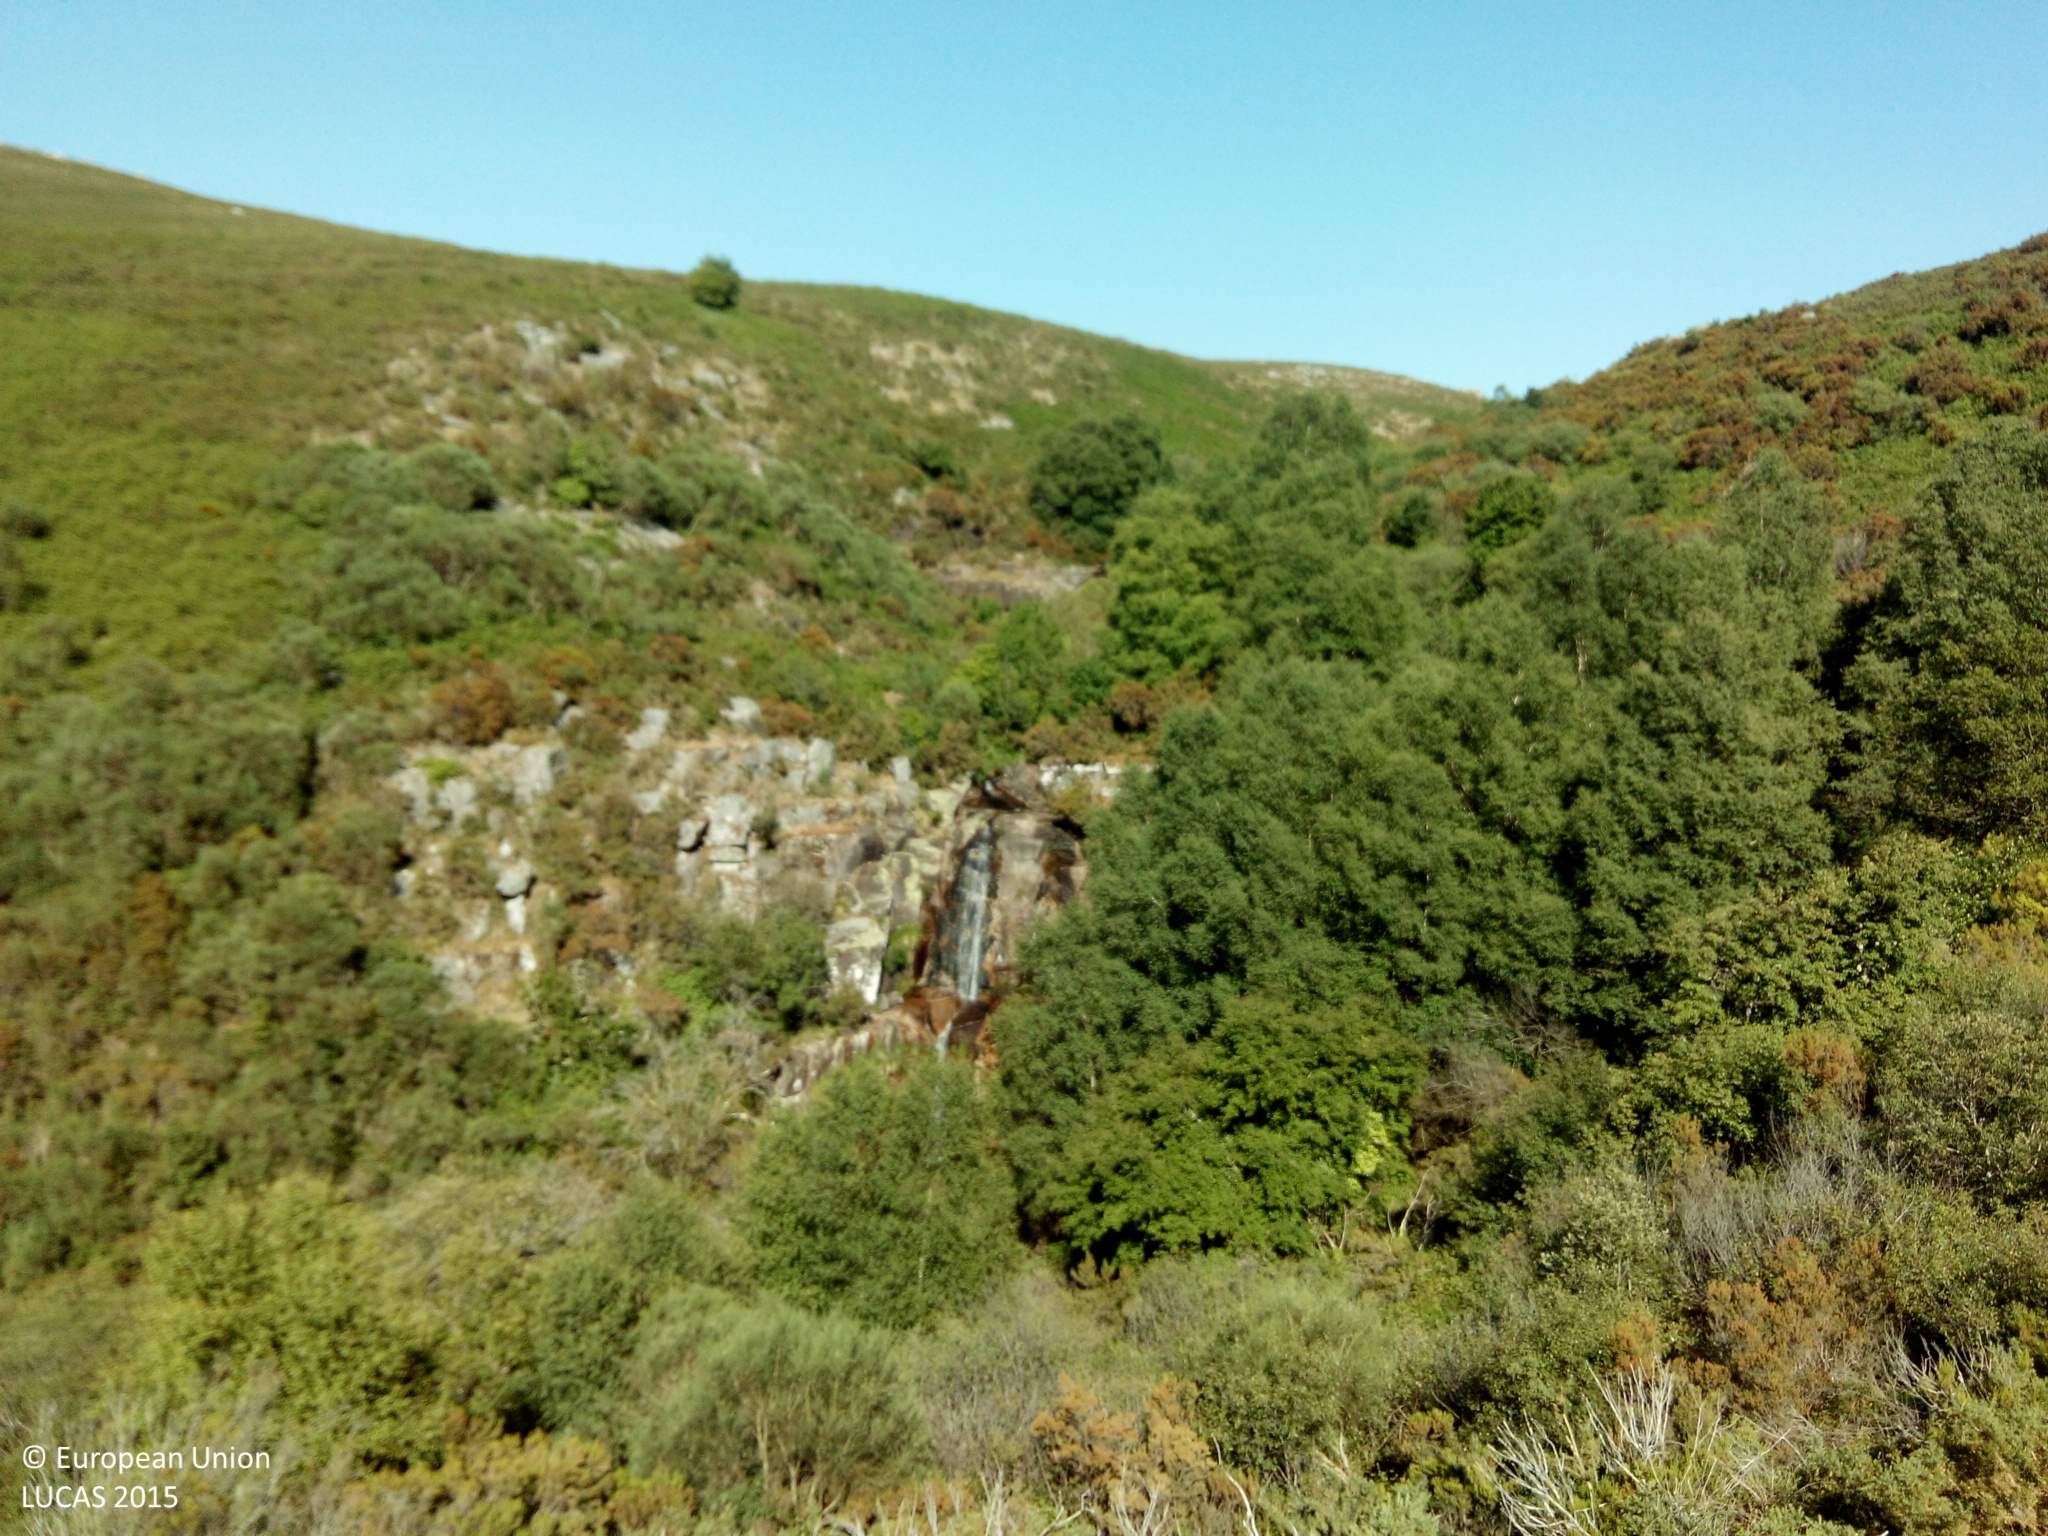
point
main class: Shrubland
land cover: Shrubland with sparse tree cover
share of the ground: > 75 %
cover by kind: shrubs 95 %, broadleaved forest trees 5 %
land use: Semi-natural and natural areas not in use
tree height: > 5 m
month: June
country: ES
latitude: 42.3440
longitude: -8.3600
